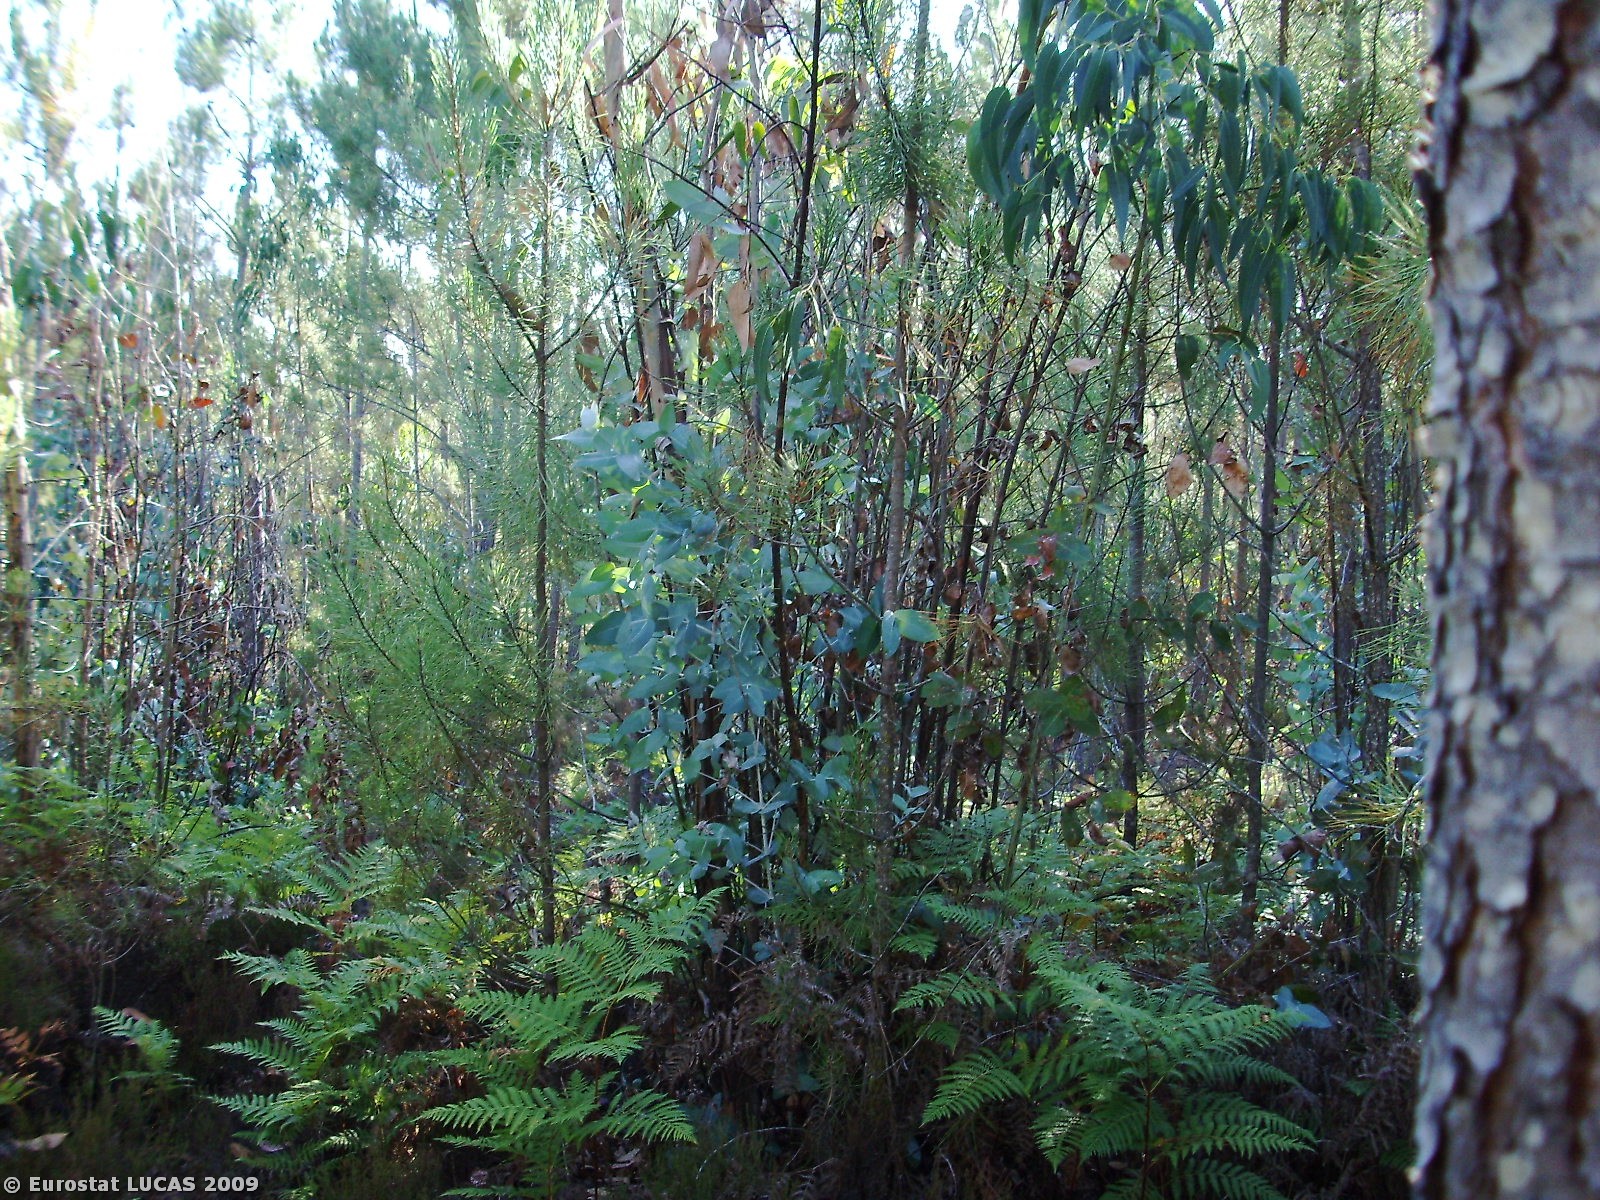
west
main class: Woodland
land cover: Coniferous woodland
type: coniferous forest of the mediterranean region
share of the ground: 50 - 75 %
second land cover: Shrubland with sparse tree cover
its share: 10 - 25 %
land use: Forestry
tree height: > 5 m
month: July
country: PT
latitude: 39.4522
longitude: -9.1606
